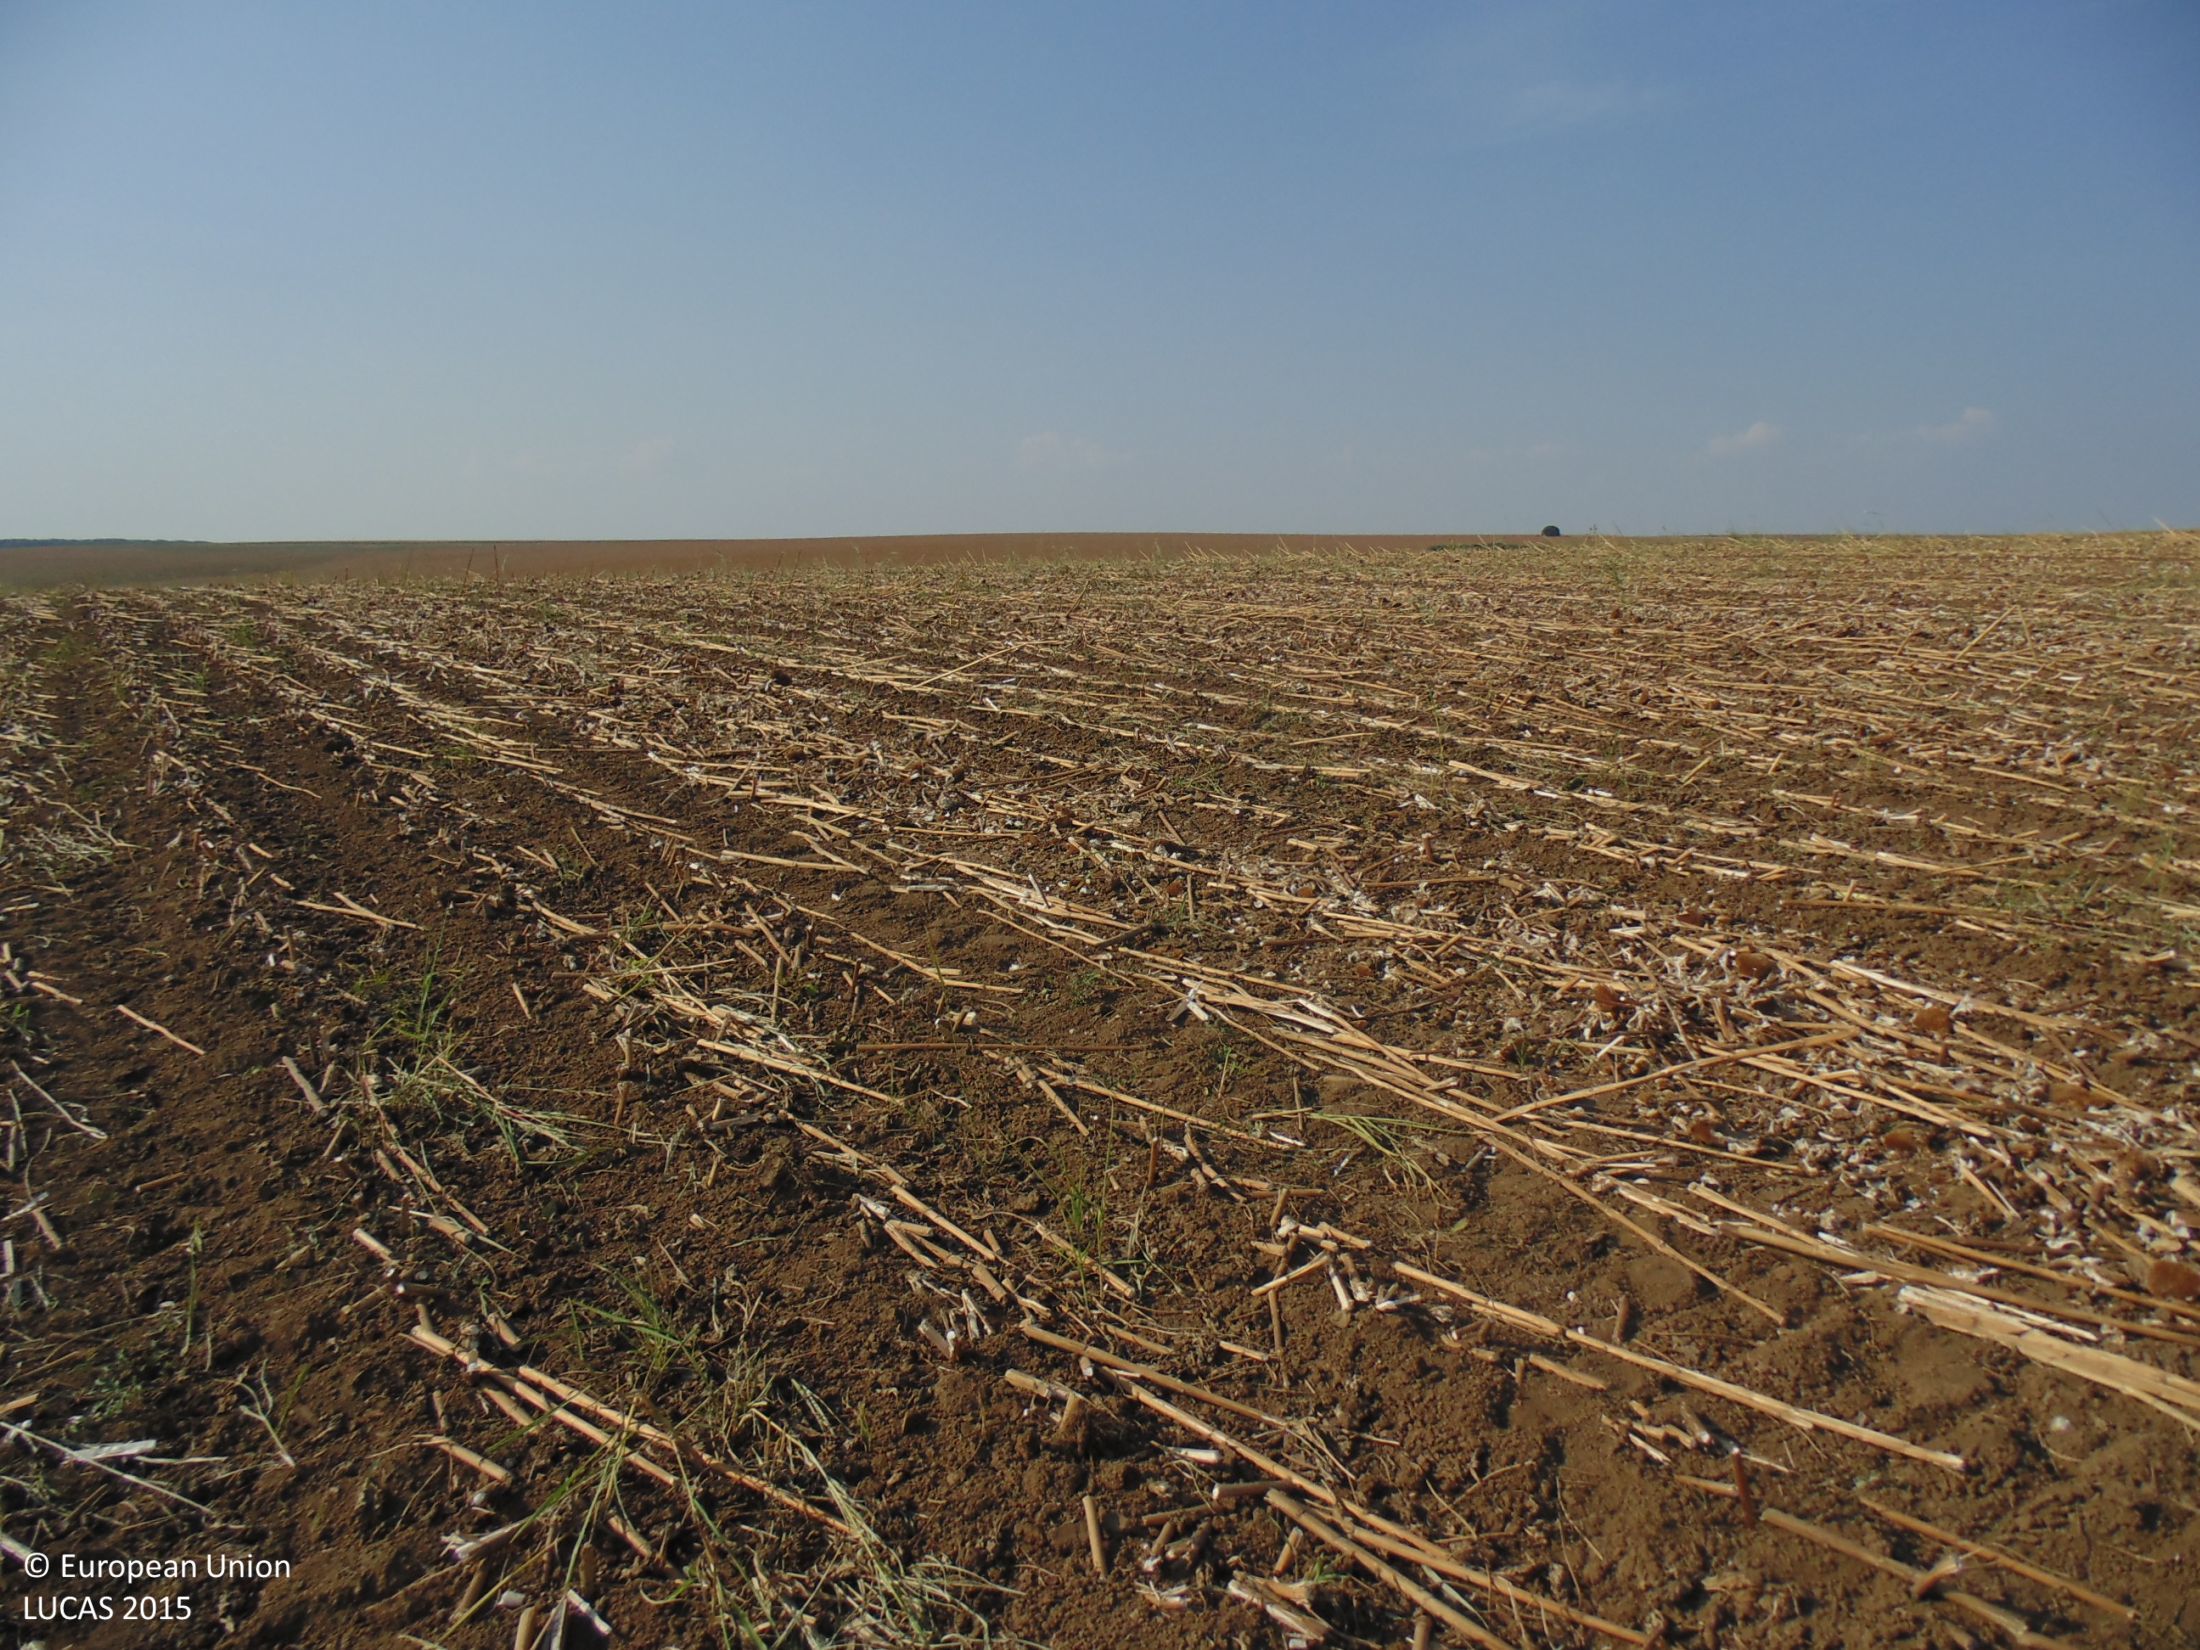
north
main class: Cropland
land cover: Sunflower
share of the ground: 10 - 25 %
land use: Agriculture (excluding fallow land and kitchen gardens)
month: August
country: BG
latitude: 43.9445
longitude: 27.2356
